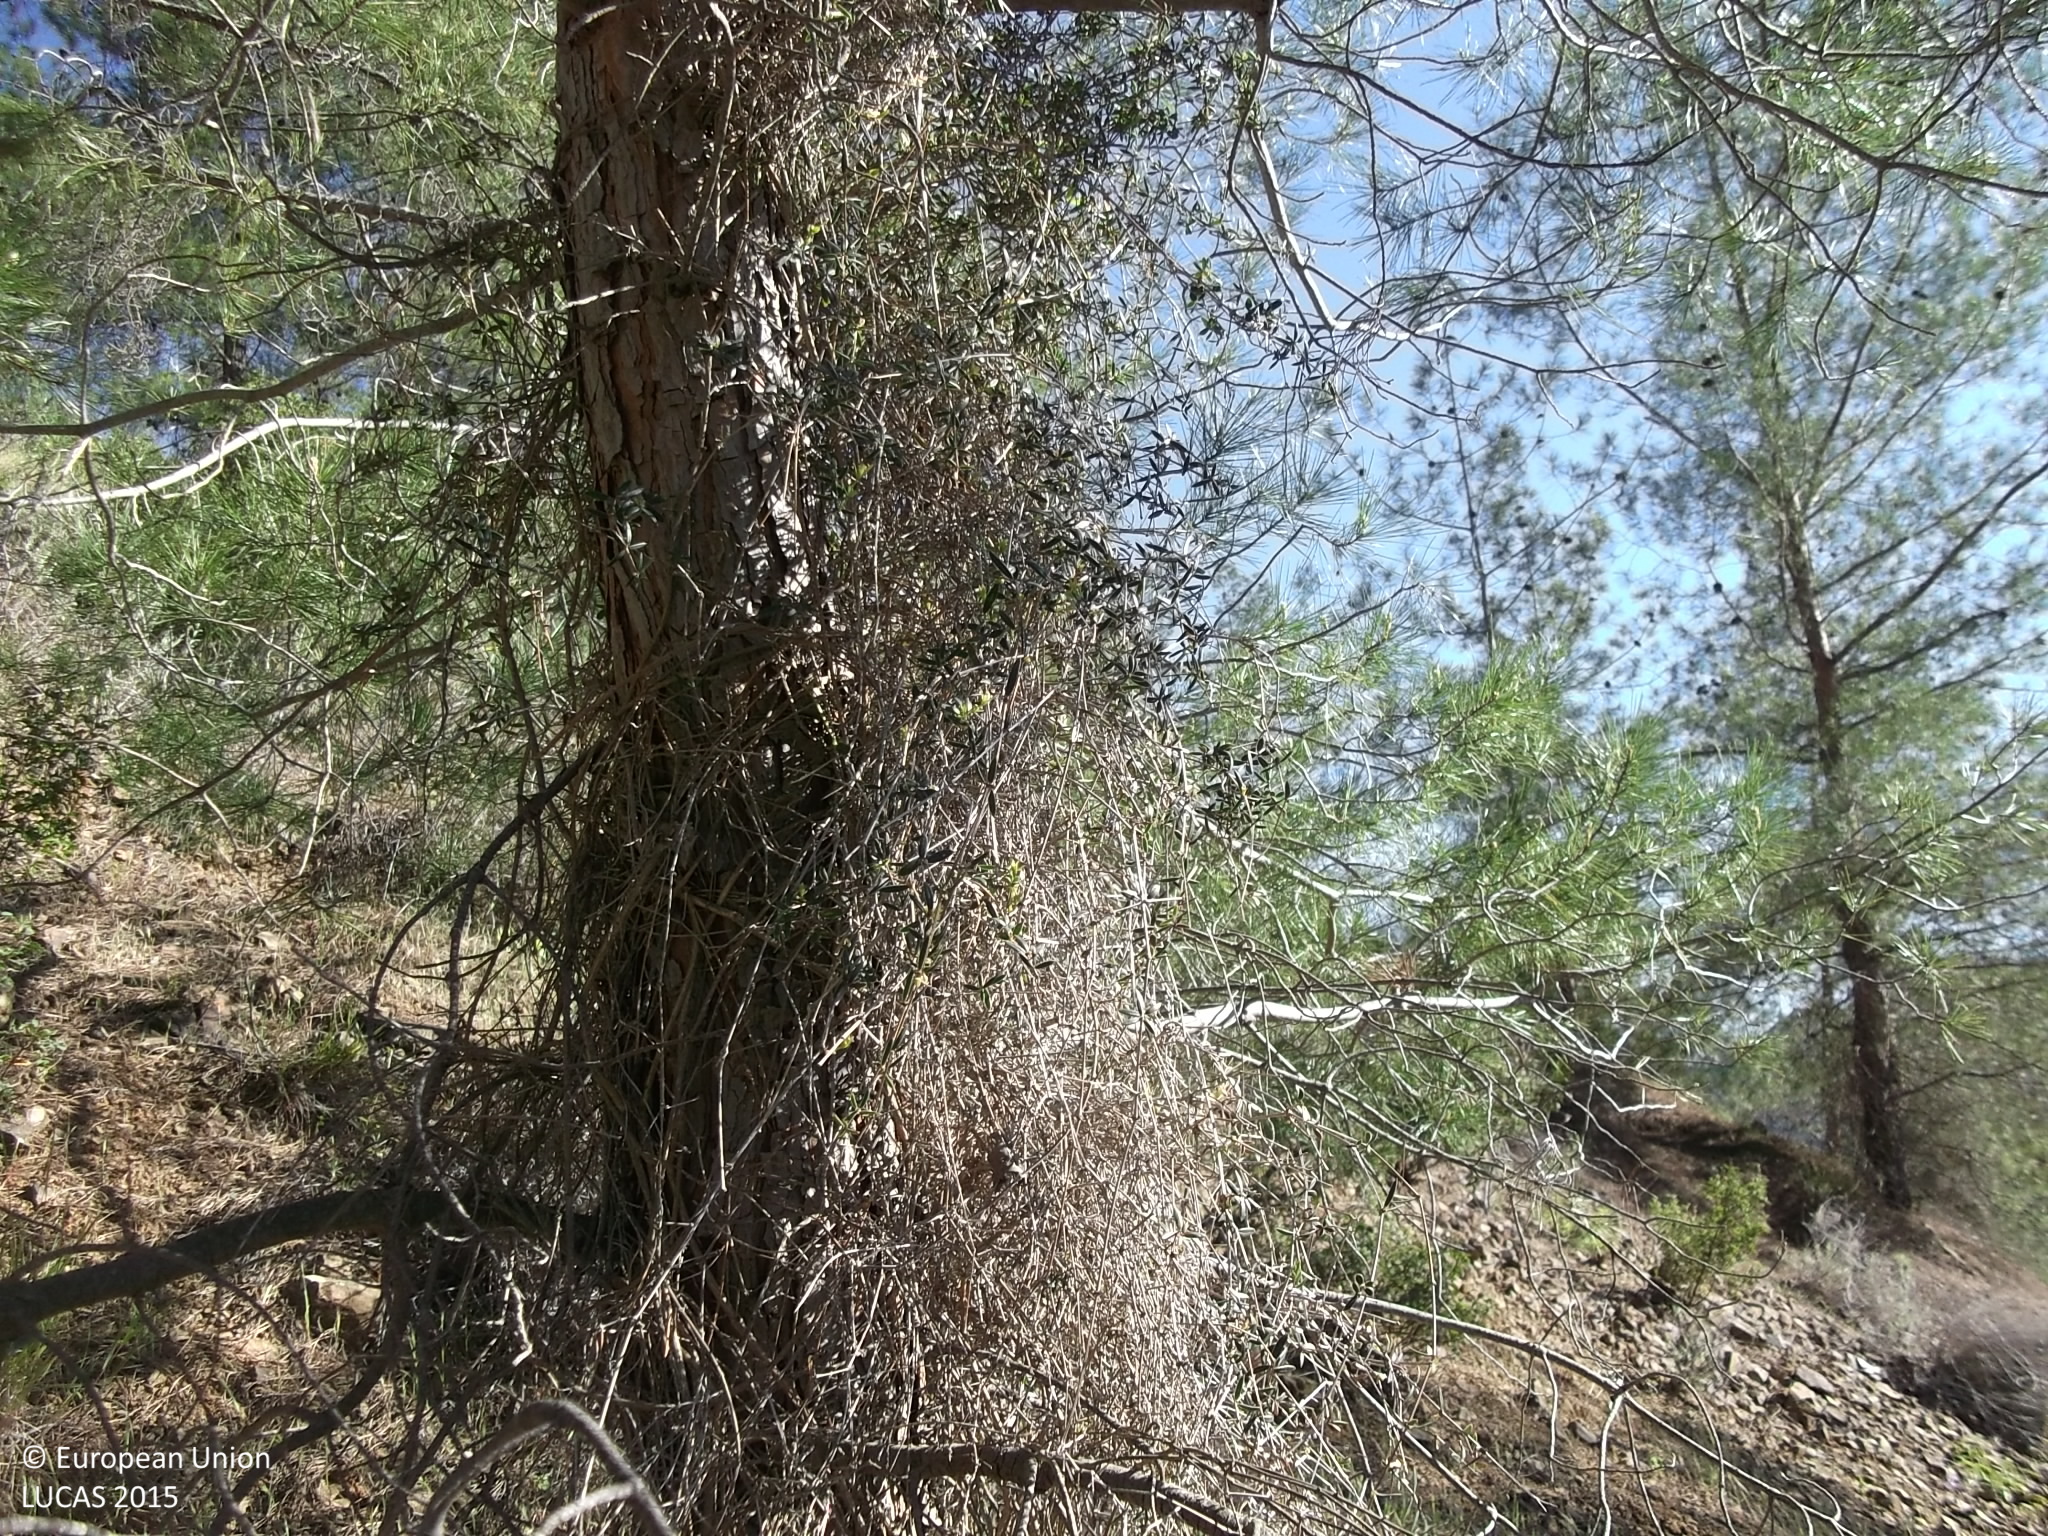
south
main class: Woodland
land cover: Pine dominated coniferous woodland
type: coniferous forest of the mediterranean region
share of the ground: 50 - 75 %
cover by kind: coniferous forest trees 55 %, shrubs 15 %, herbaceous plants 10 %, consolidated bare surface 10 %, unconsolidated bare surface 10 %
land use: Semi-natural and natural areas not in use
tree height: > 5 m
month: April
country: CY
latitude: 34.9287
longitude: 33.1331
